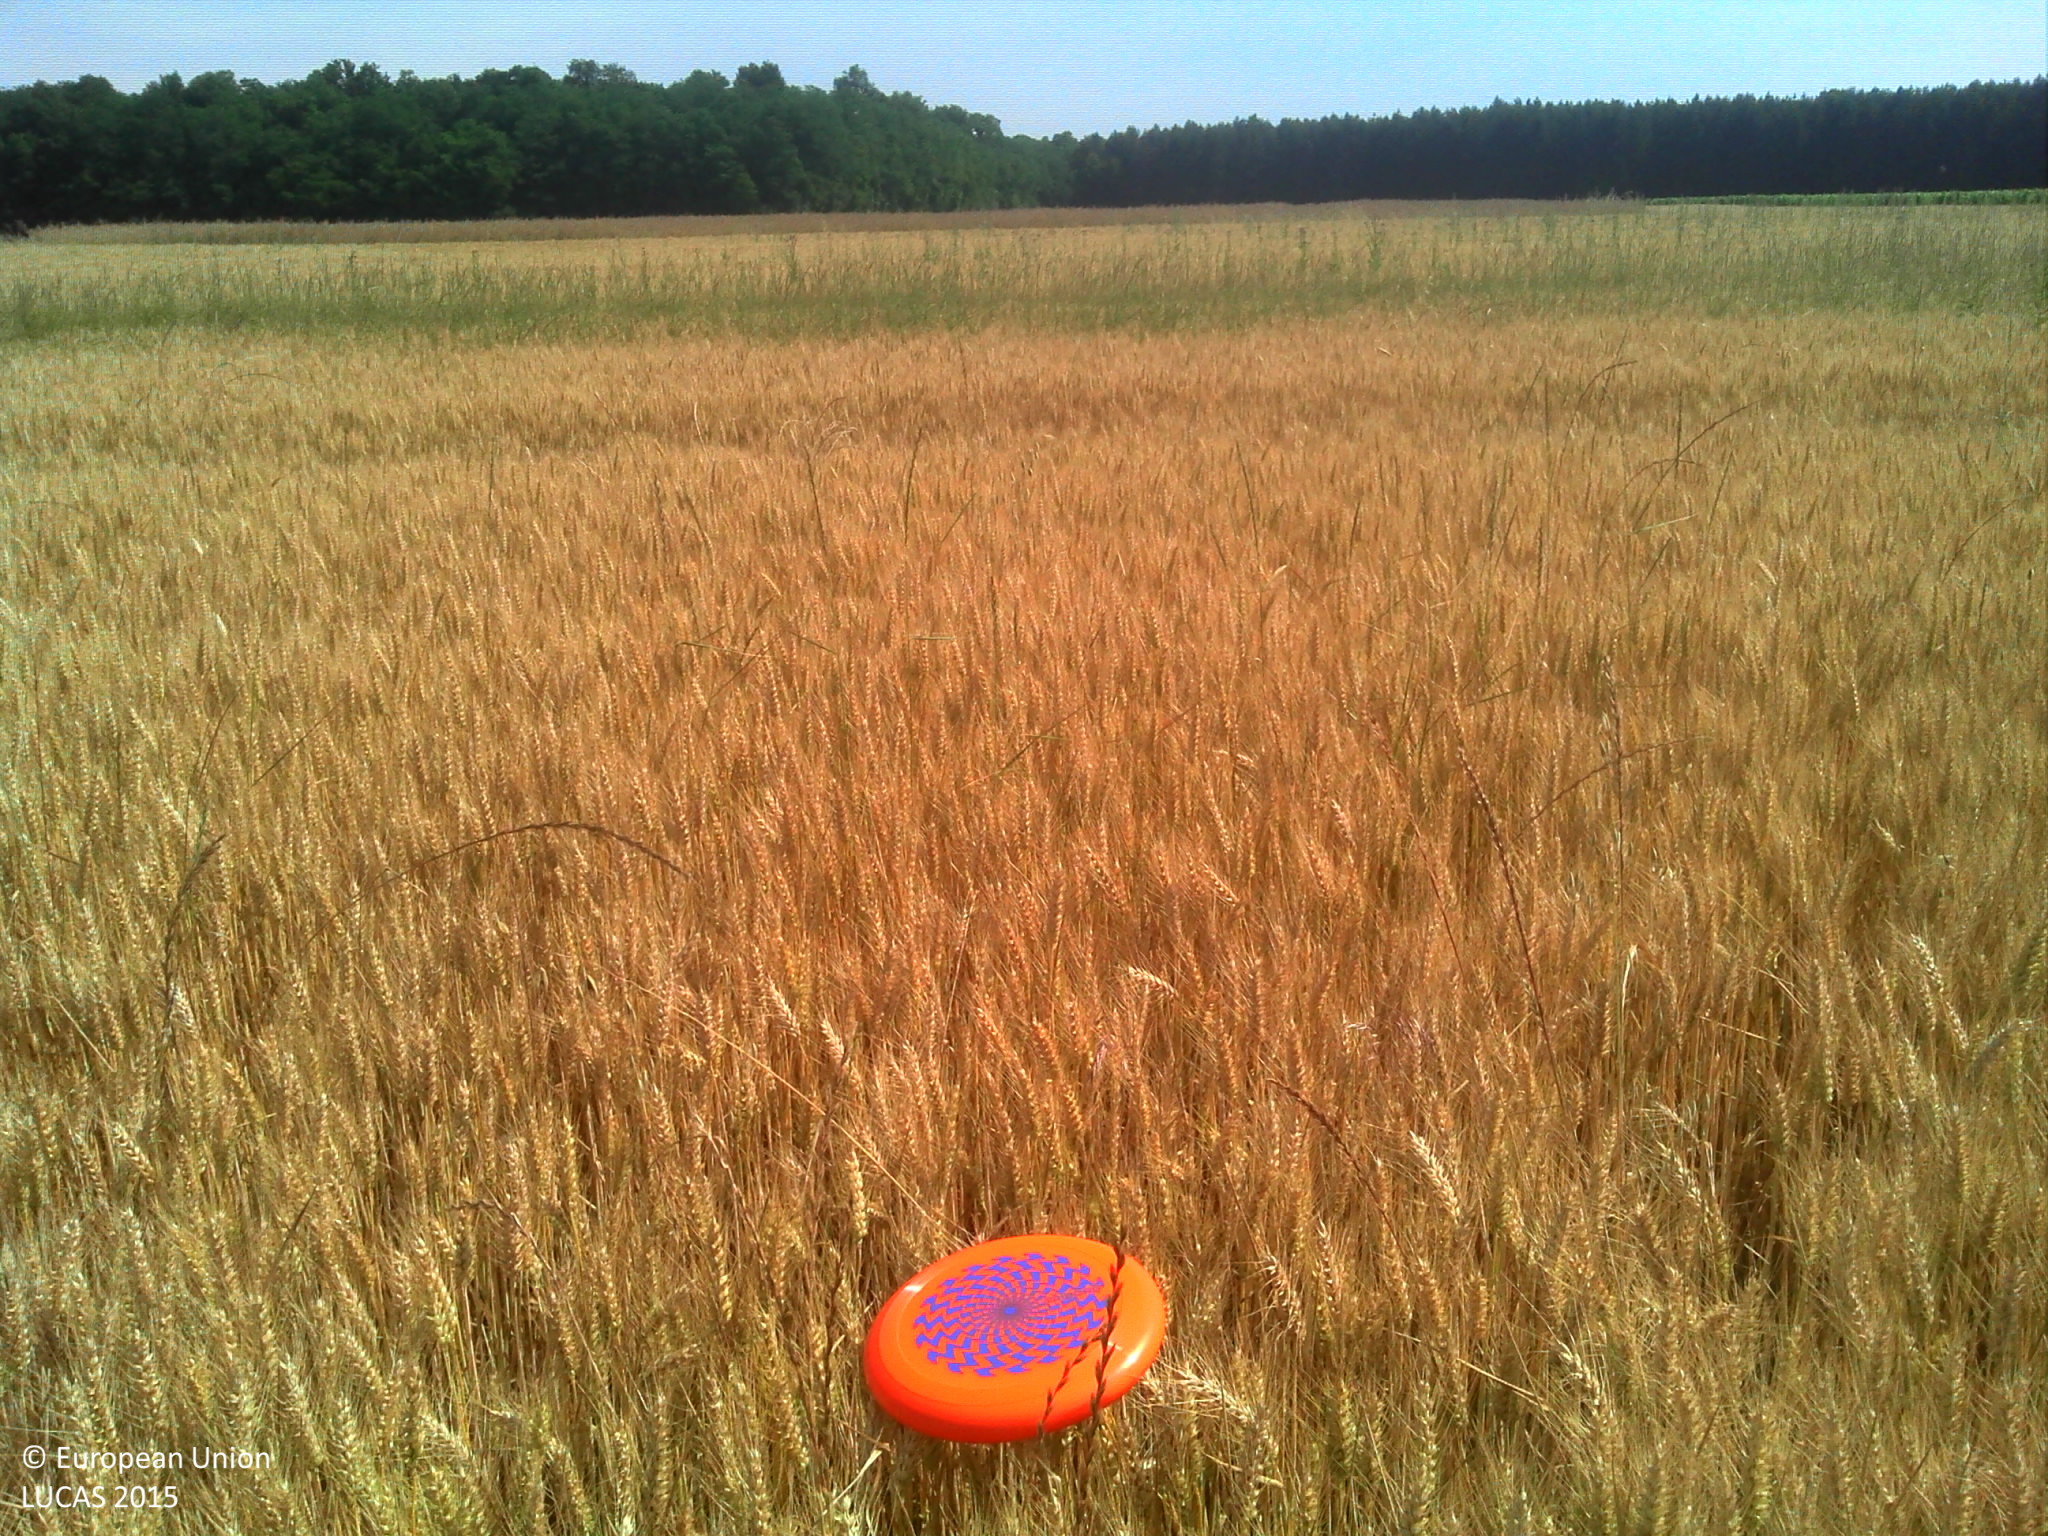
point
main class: Cropland
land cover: Common wheat
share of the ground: > 75 %
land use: Agriculture (excluding fallow land and kitchen gardens)
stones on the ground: < 10 %
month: June
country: FR
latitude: 47.5066
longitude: 1.3953
